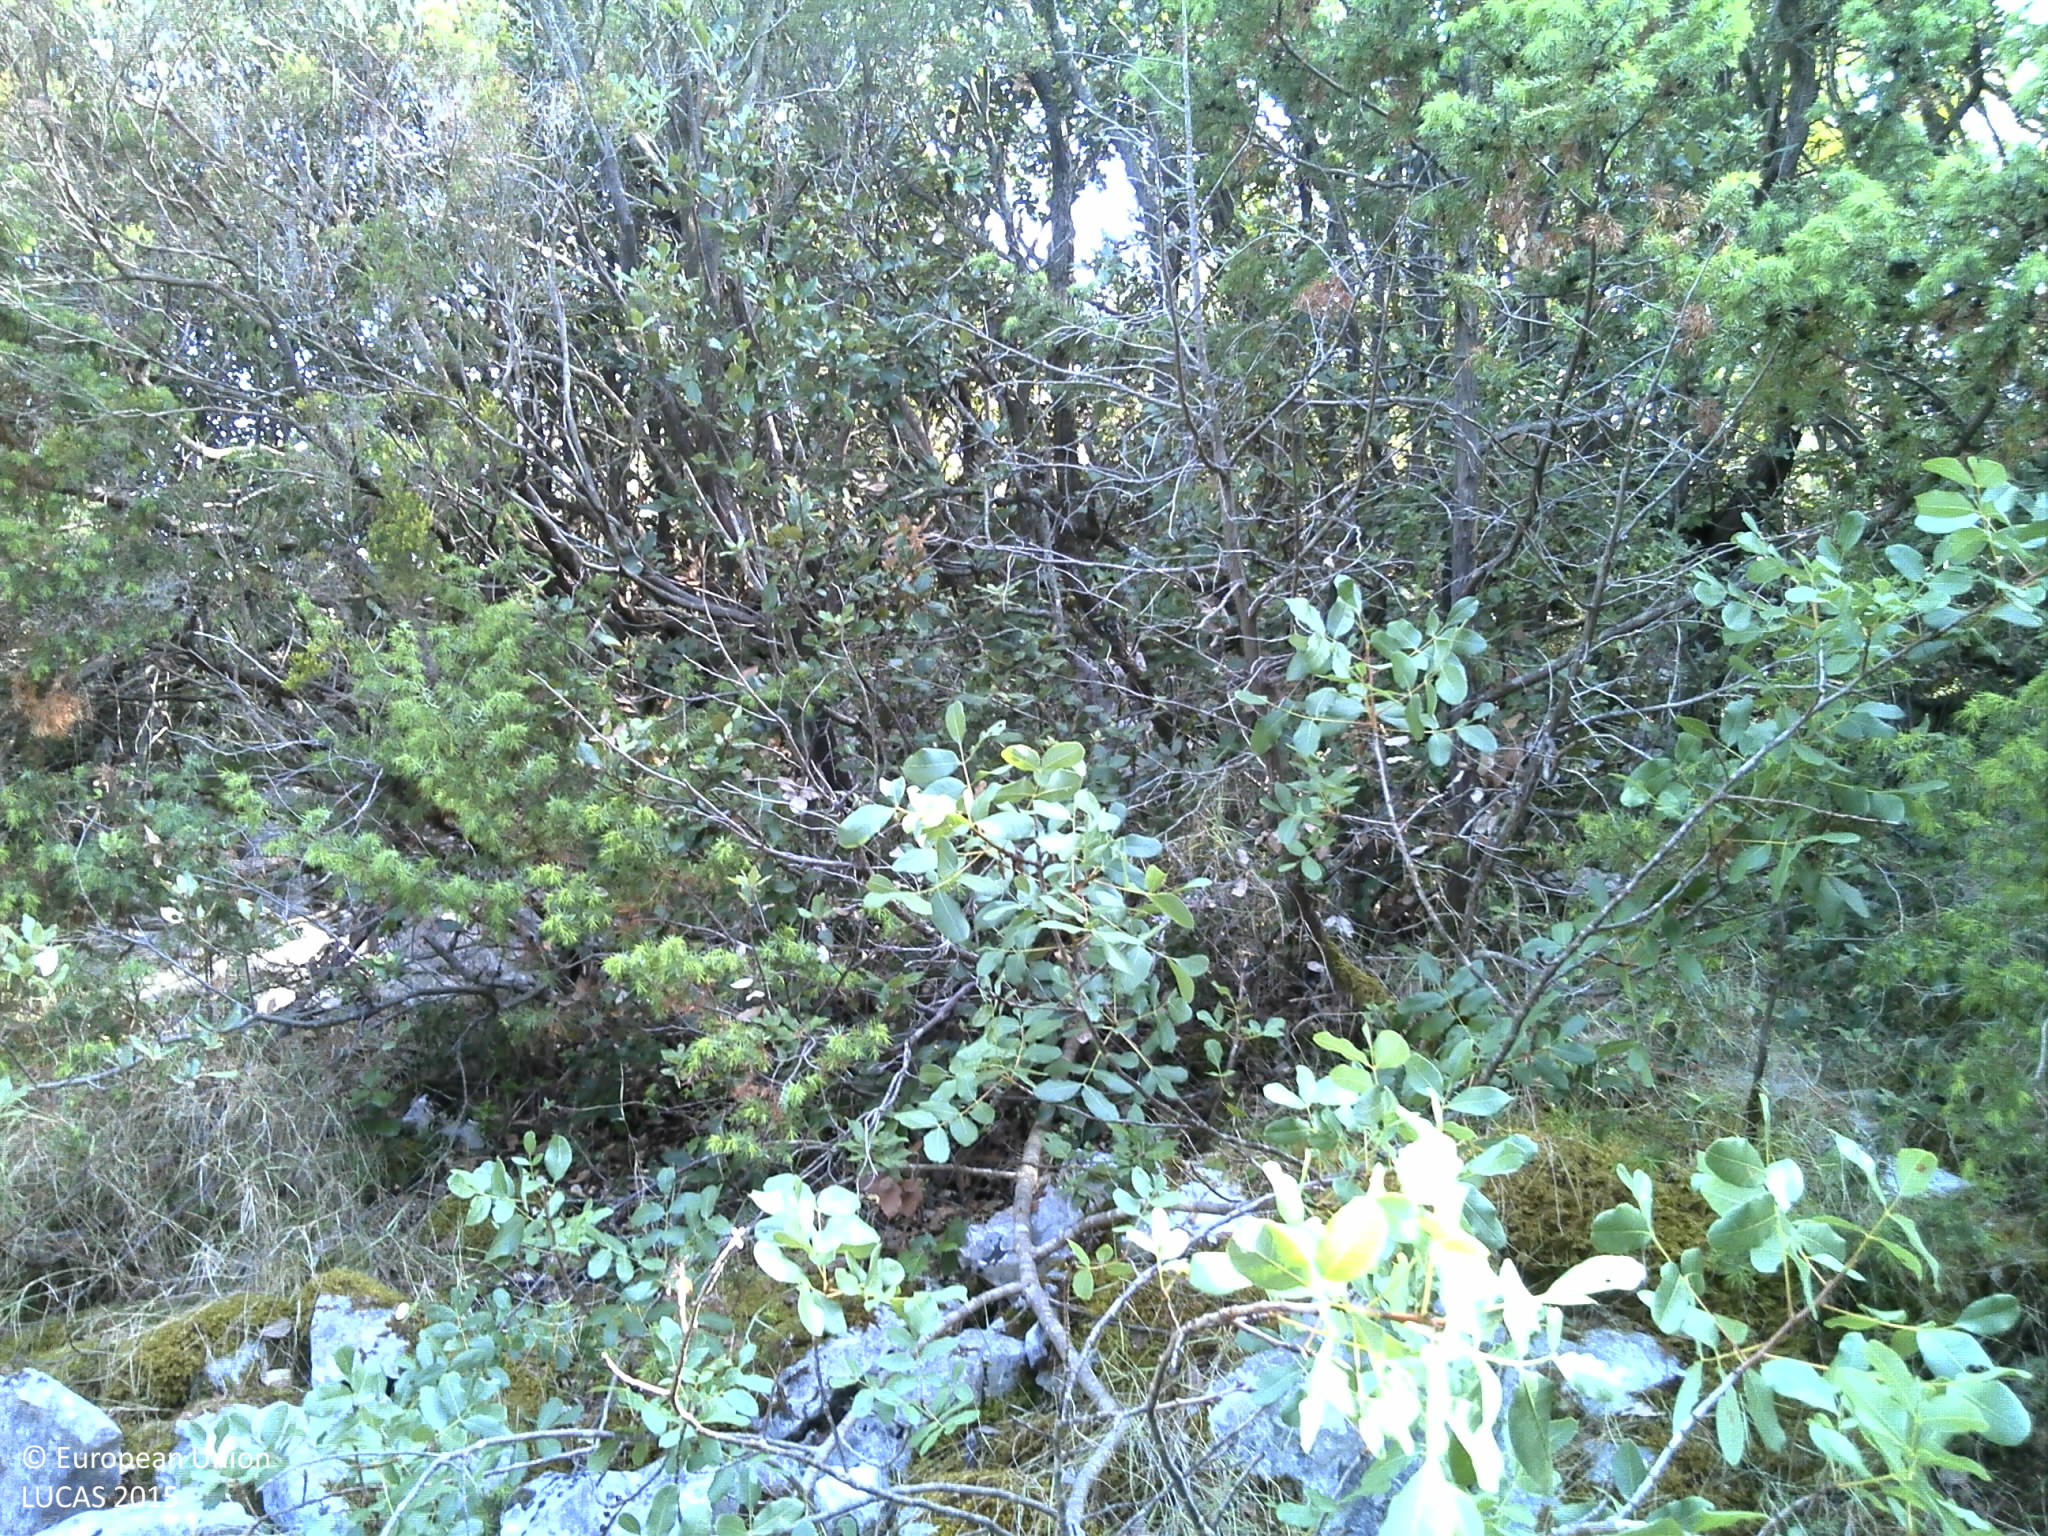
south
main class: Shrubland
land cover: Shrubland with sparse tree cover
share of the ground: > 75 %
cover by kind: shrubs 75 %, broadleaved forest trees 5 %, herbaceous plants 5 %, lichens and mosses 5 %, consolidated bare surface 5 %, unconsolidated bare surface 5 %
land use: Semi-natural and natural areas not in use
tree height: < 5 m
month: August
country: HR
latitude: 43.1390
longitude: 16.9609
